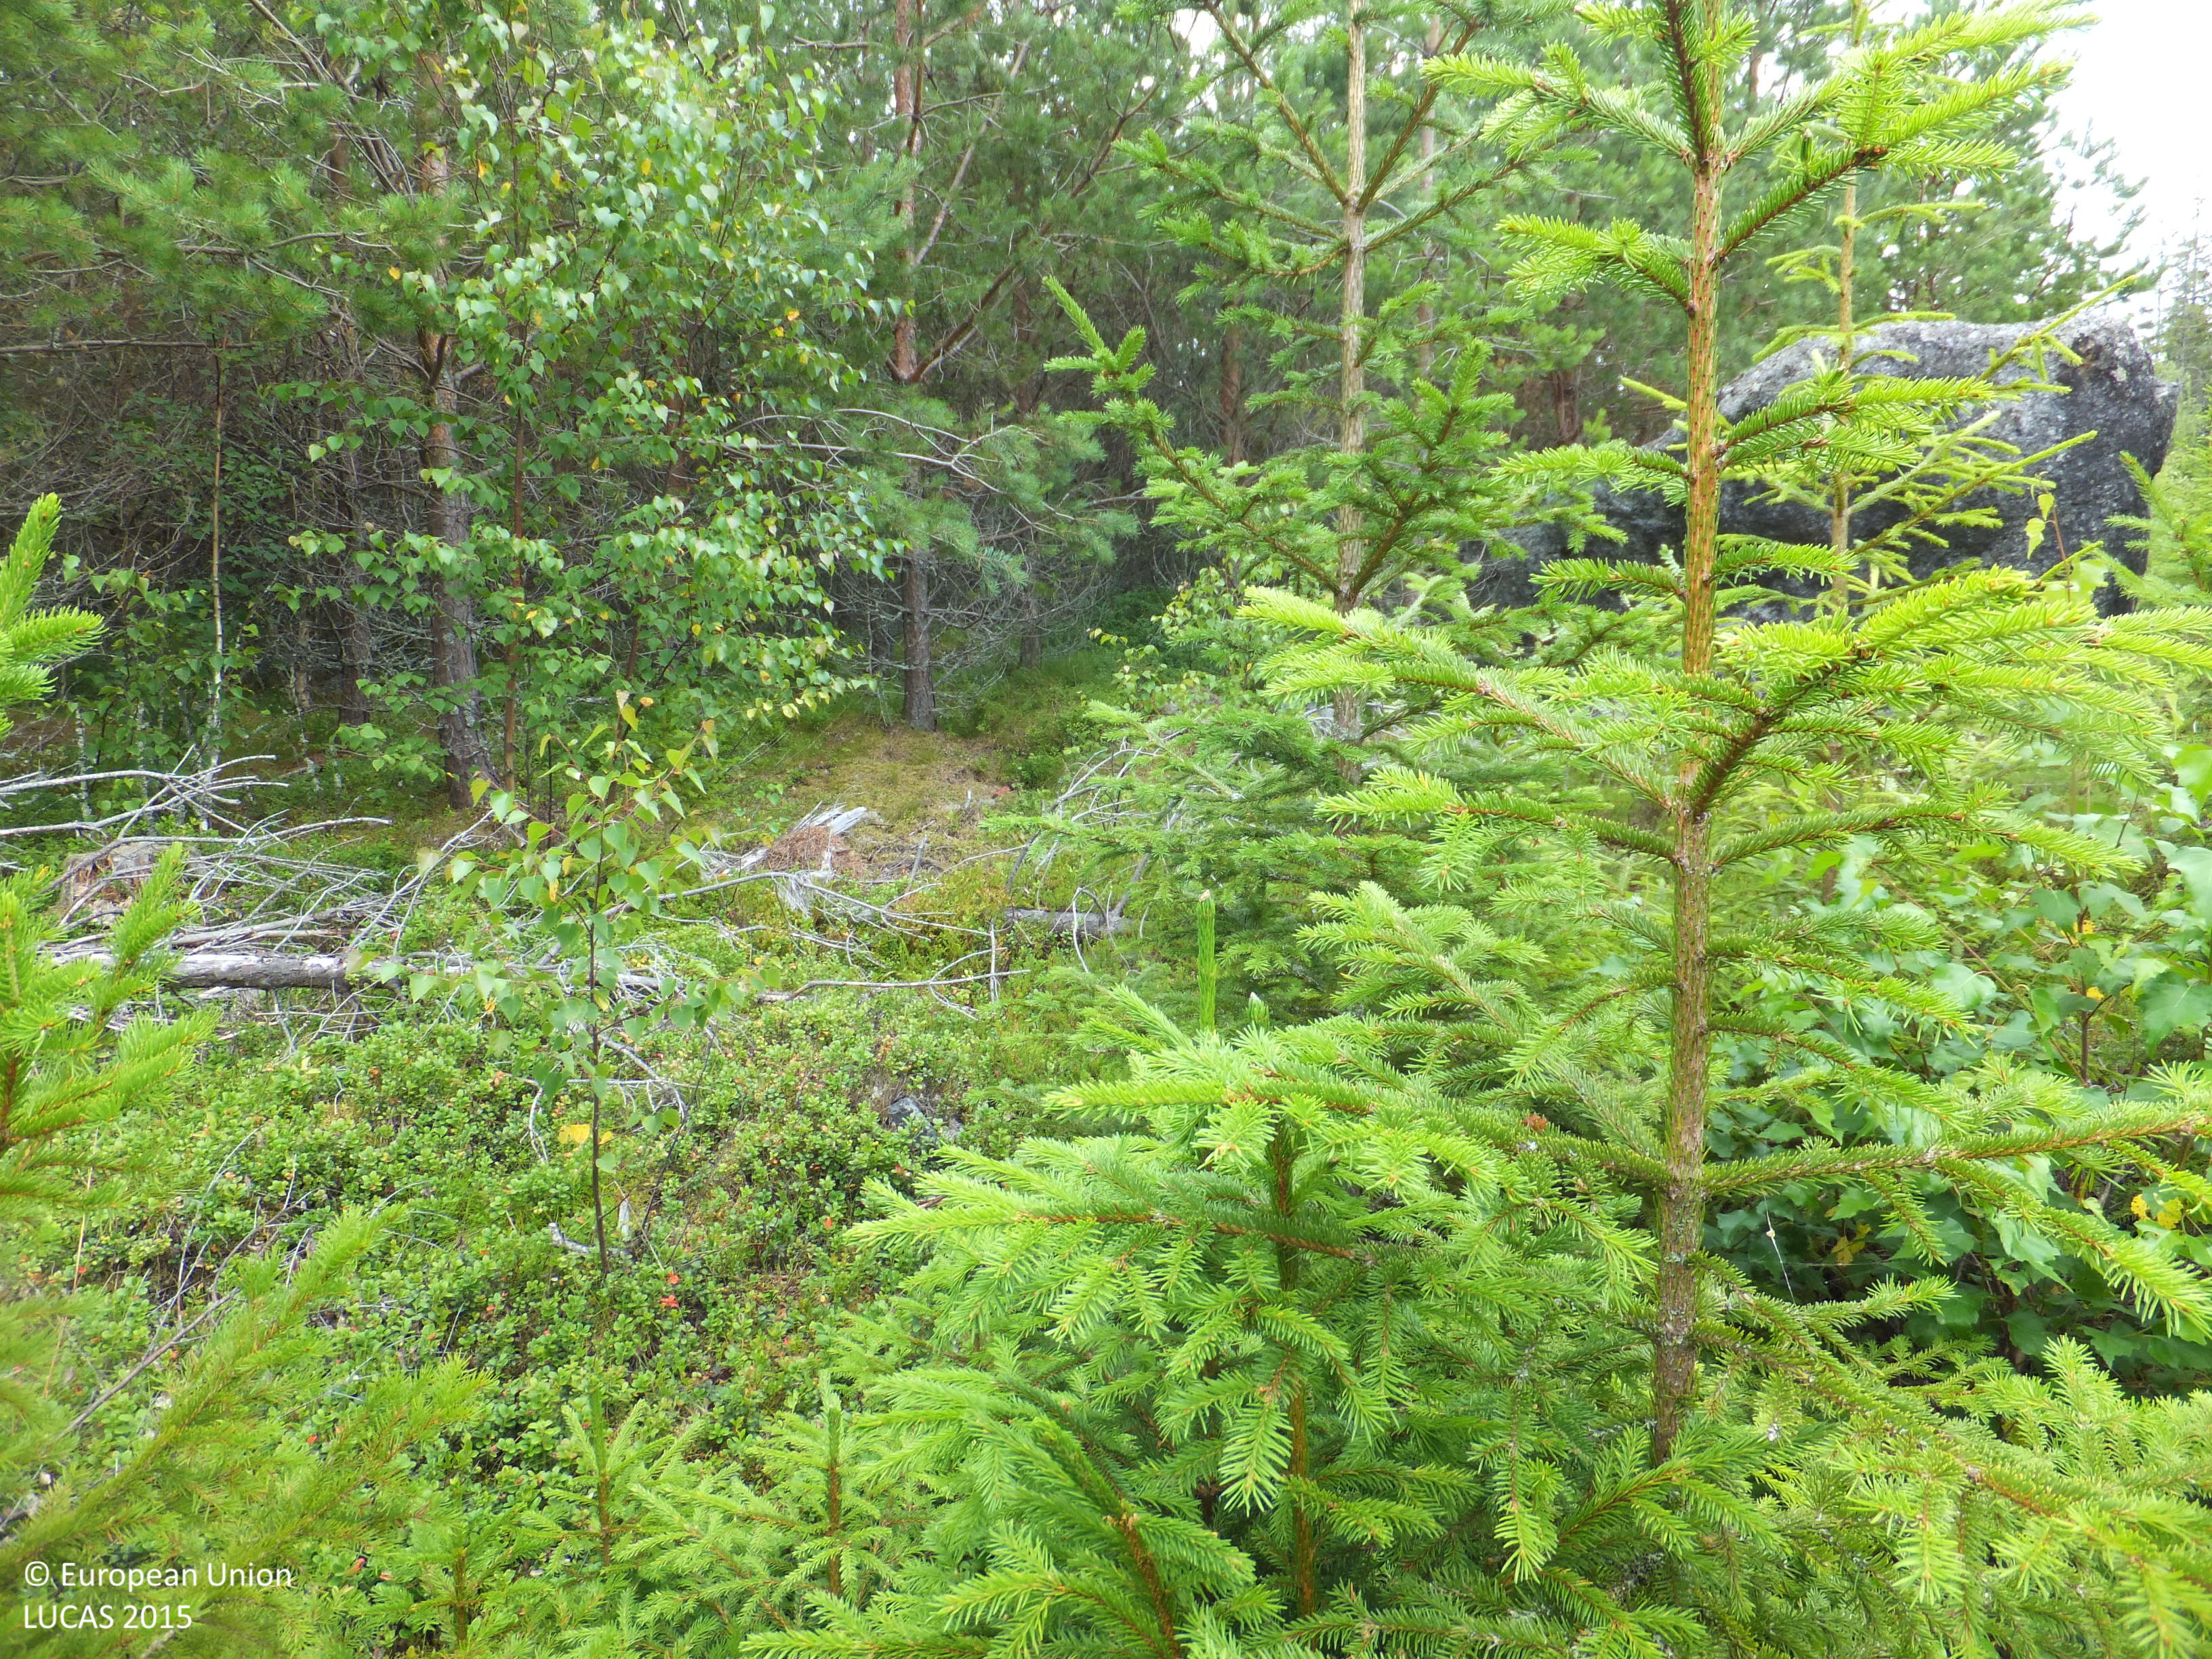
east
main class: Woodland
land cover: Spruce dominated mixed woodland
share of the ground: 25 - 50 %
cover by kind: shrubs 40 %, coniferous forest trees 15 %, broadleaved forest trees 15 %, herbaceous plants 10 %, lichens and mosses 10 %, consolidated bare surface 10 %
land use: Forestry
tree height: < 5 m
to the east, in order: Spruce dominated mixed woodland; Pine dominated coniferous woodland; Spruce dominated mixed woodland; Transitional water bodies
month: July
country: FI
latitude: 63.2954
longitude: 21.1029
